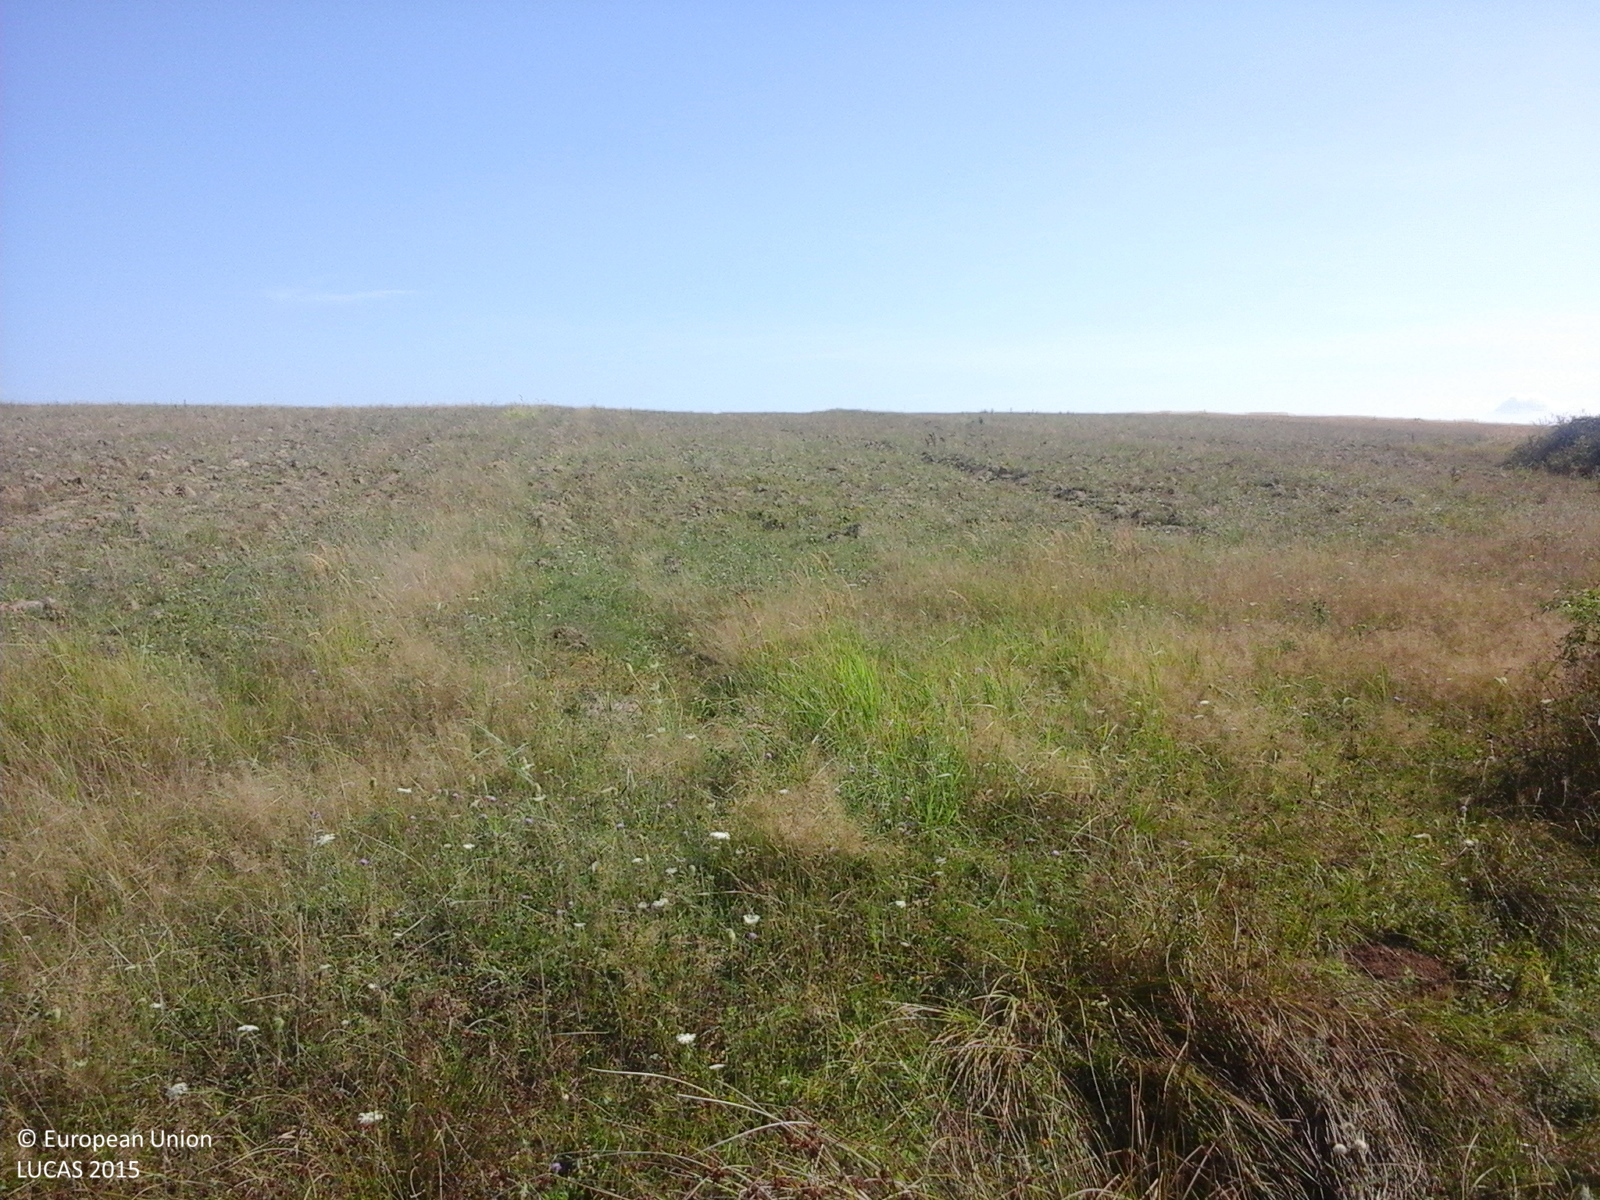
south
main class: Grassland
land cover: Grassland with sparse tree/shrub cover
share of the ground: > 75 %
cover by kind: herbaceous plants 90 %, broadleaved forest trees 5 %, shrubs 5 %
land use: Agriculture (excluding fallow land and kitchen gardens)
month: August
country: RO
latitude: 45.3678
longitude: 21.6391
